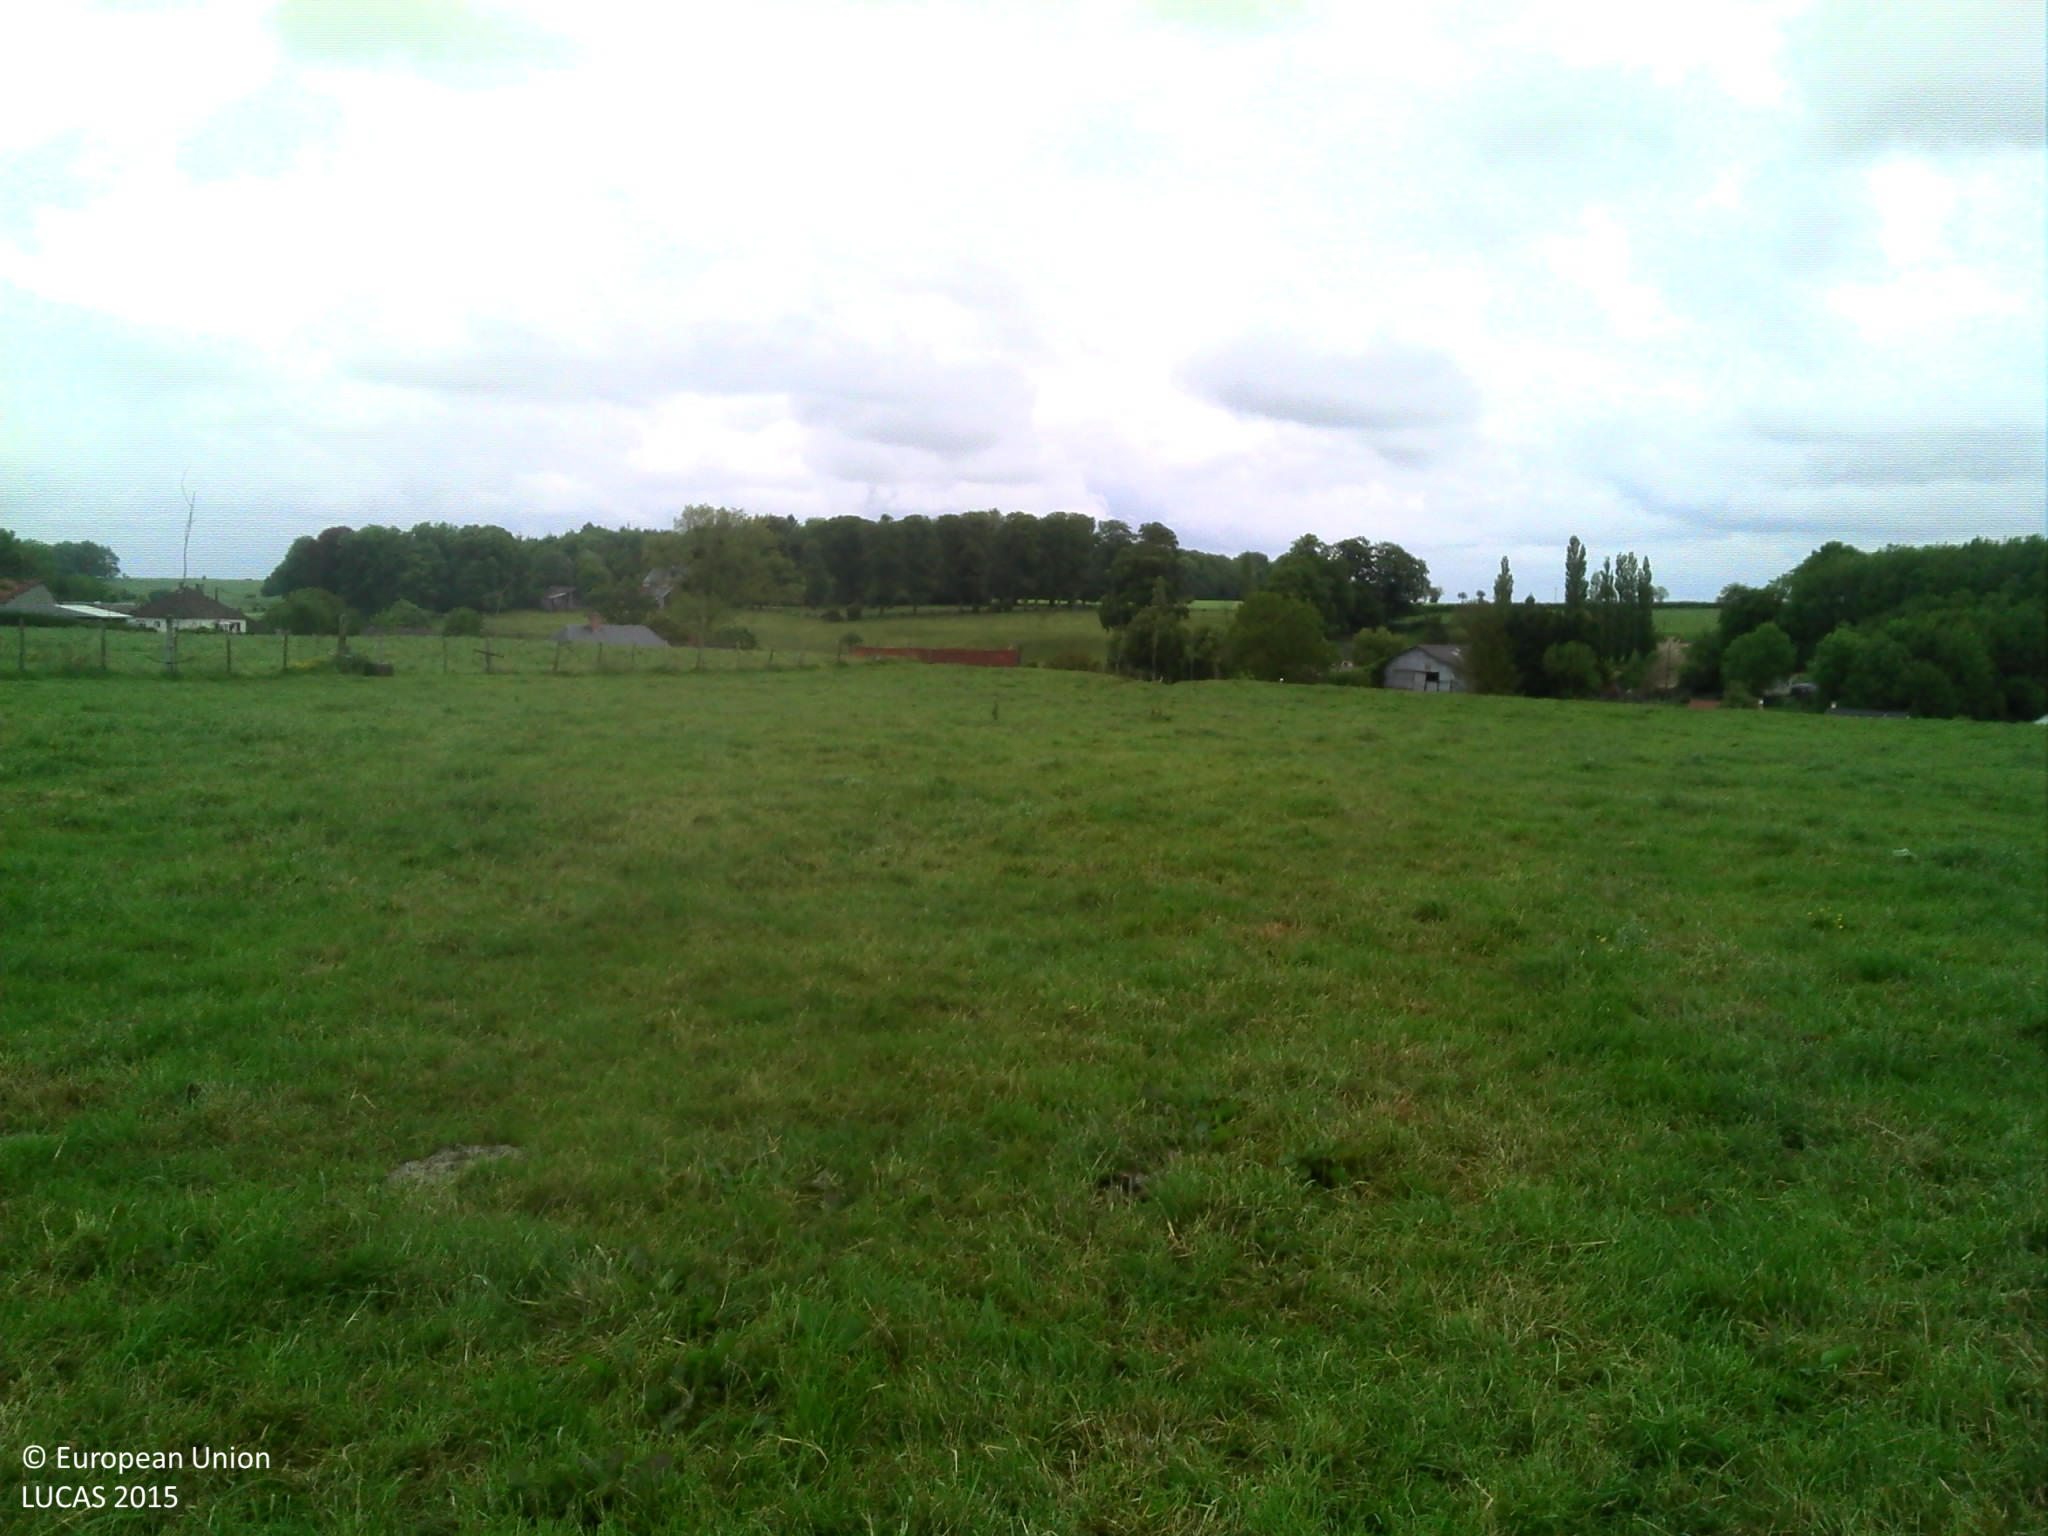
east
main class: Grassland
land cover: Grassland without tree/shrub cover
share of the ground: > 75 %
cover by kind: herbaceous plants 100 %
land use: Agriculture (excluding fallow land and kitchen gardens)
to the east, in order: Grassland without tree/shrub cover; Lines of trees; Fences; Grassland without tree/shrub cover; Fences; Grassland with sparse tree/shrub cover; Artificial constructions in urban areas; Grassland without tree/shrub cover
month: May
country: FR
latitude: 50.0599
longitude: 1.6710
